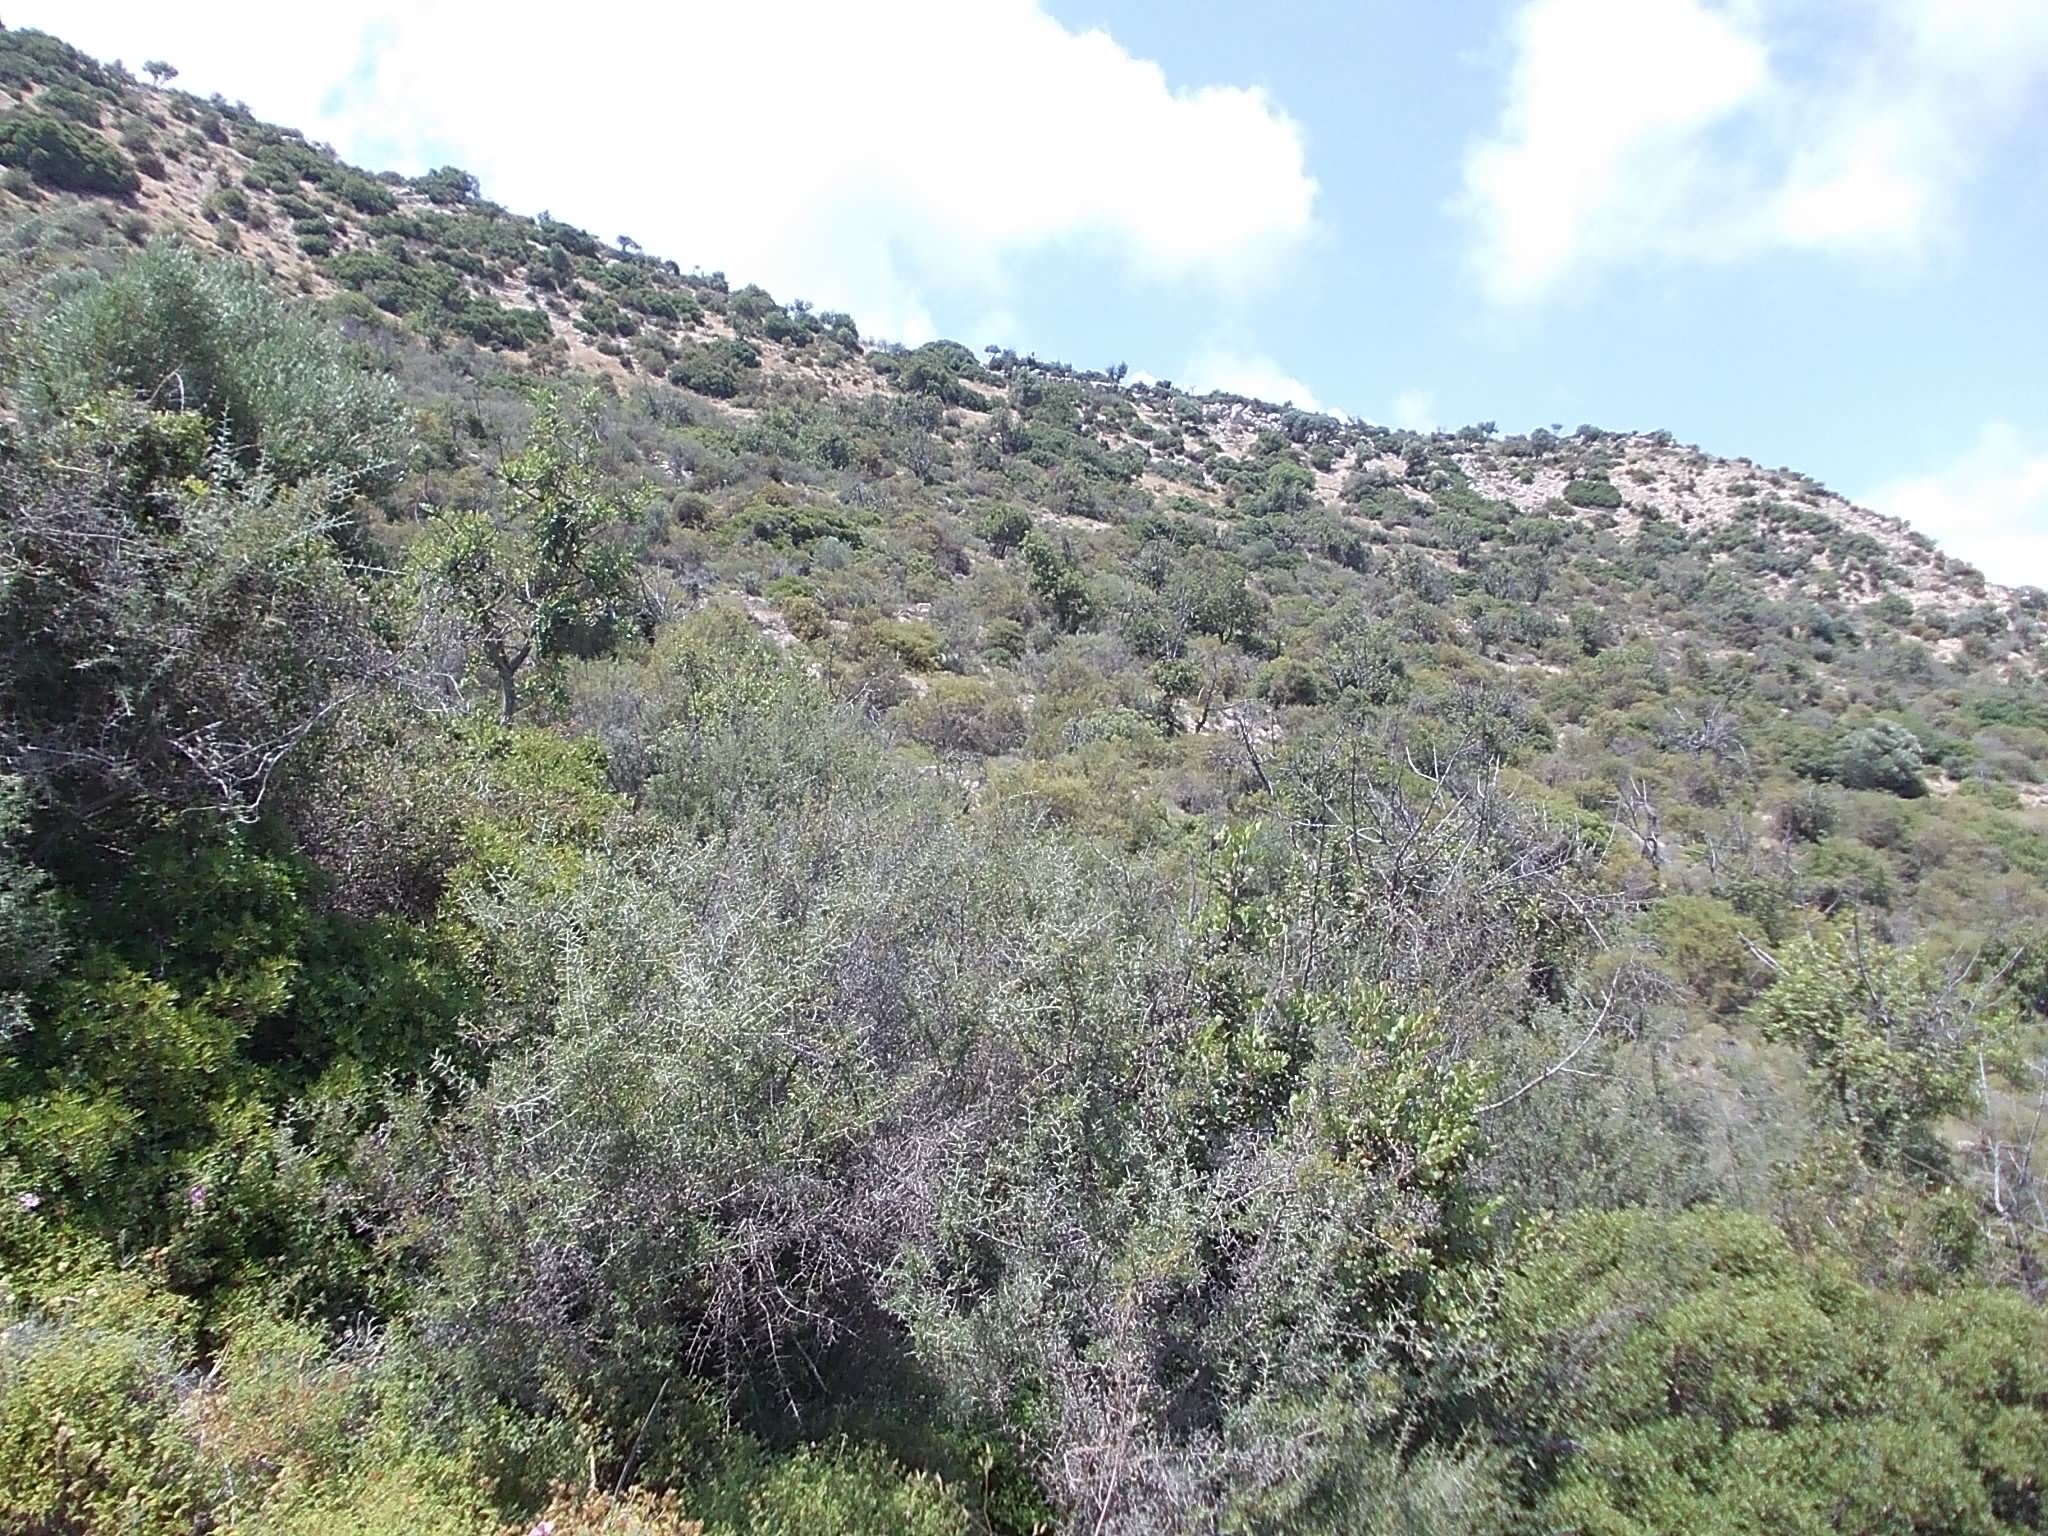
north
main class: Shrubland
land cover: Shrubland without tree cover
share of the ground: > 75 %
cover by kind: shrubs 85 %, unconsolidated bare surface 15 %
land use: Semi-natural and natural areas not in use
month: June
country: CY
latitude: 34.7197
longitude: 32.7022
